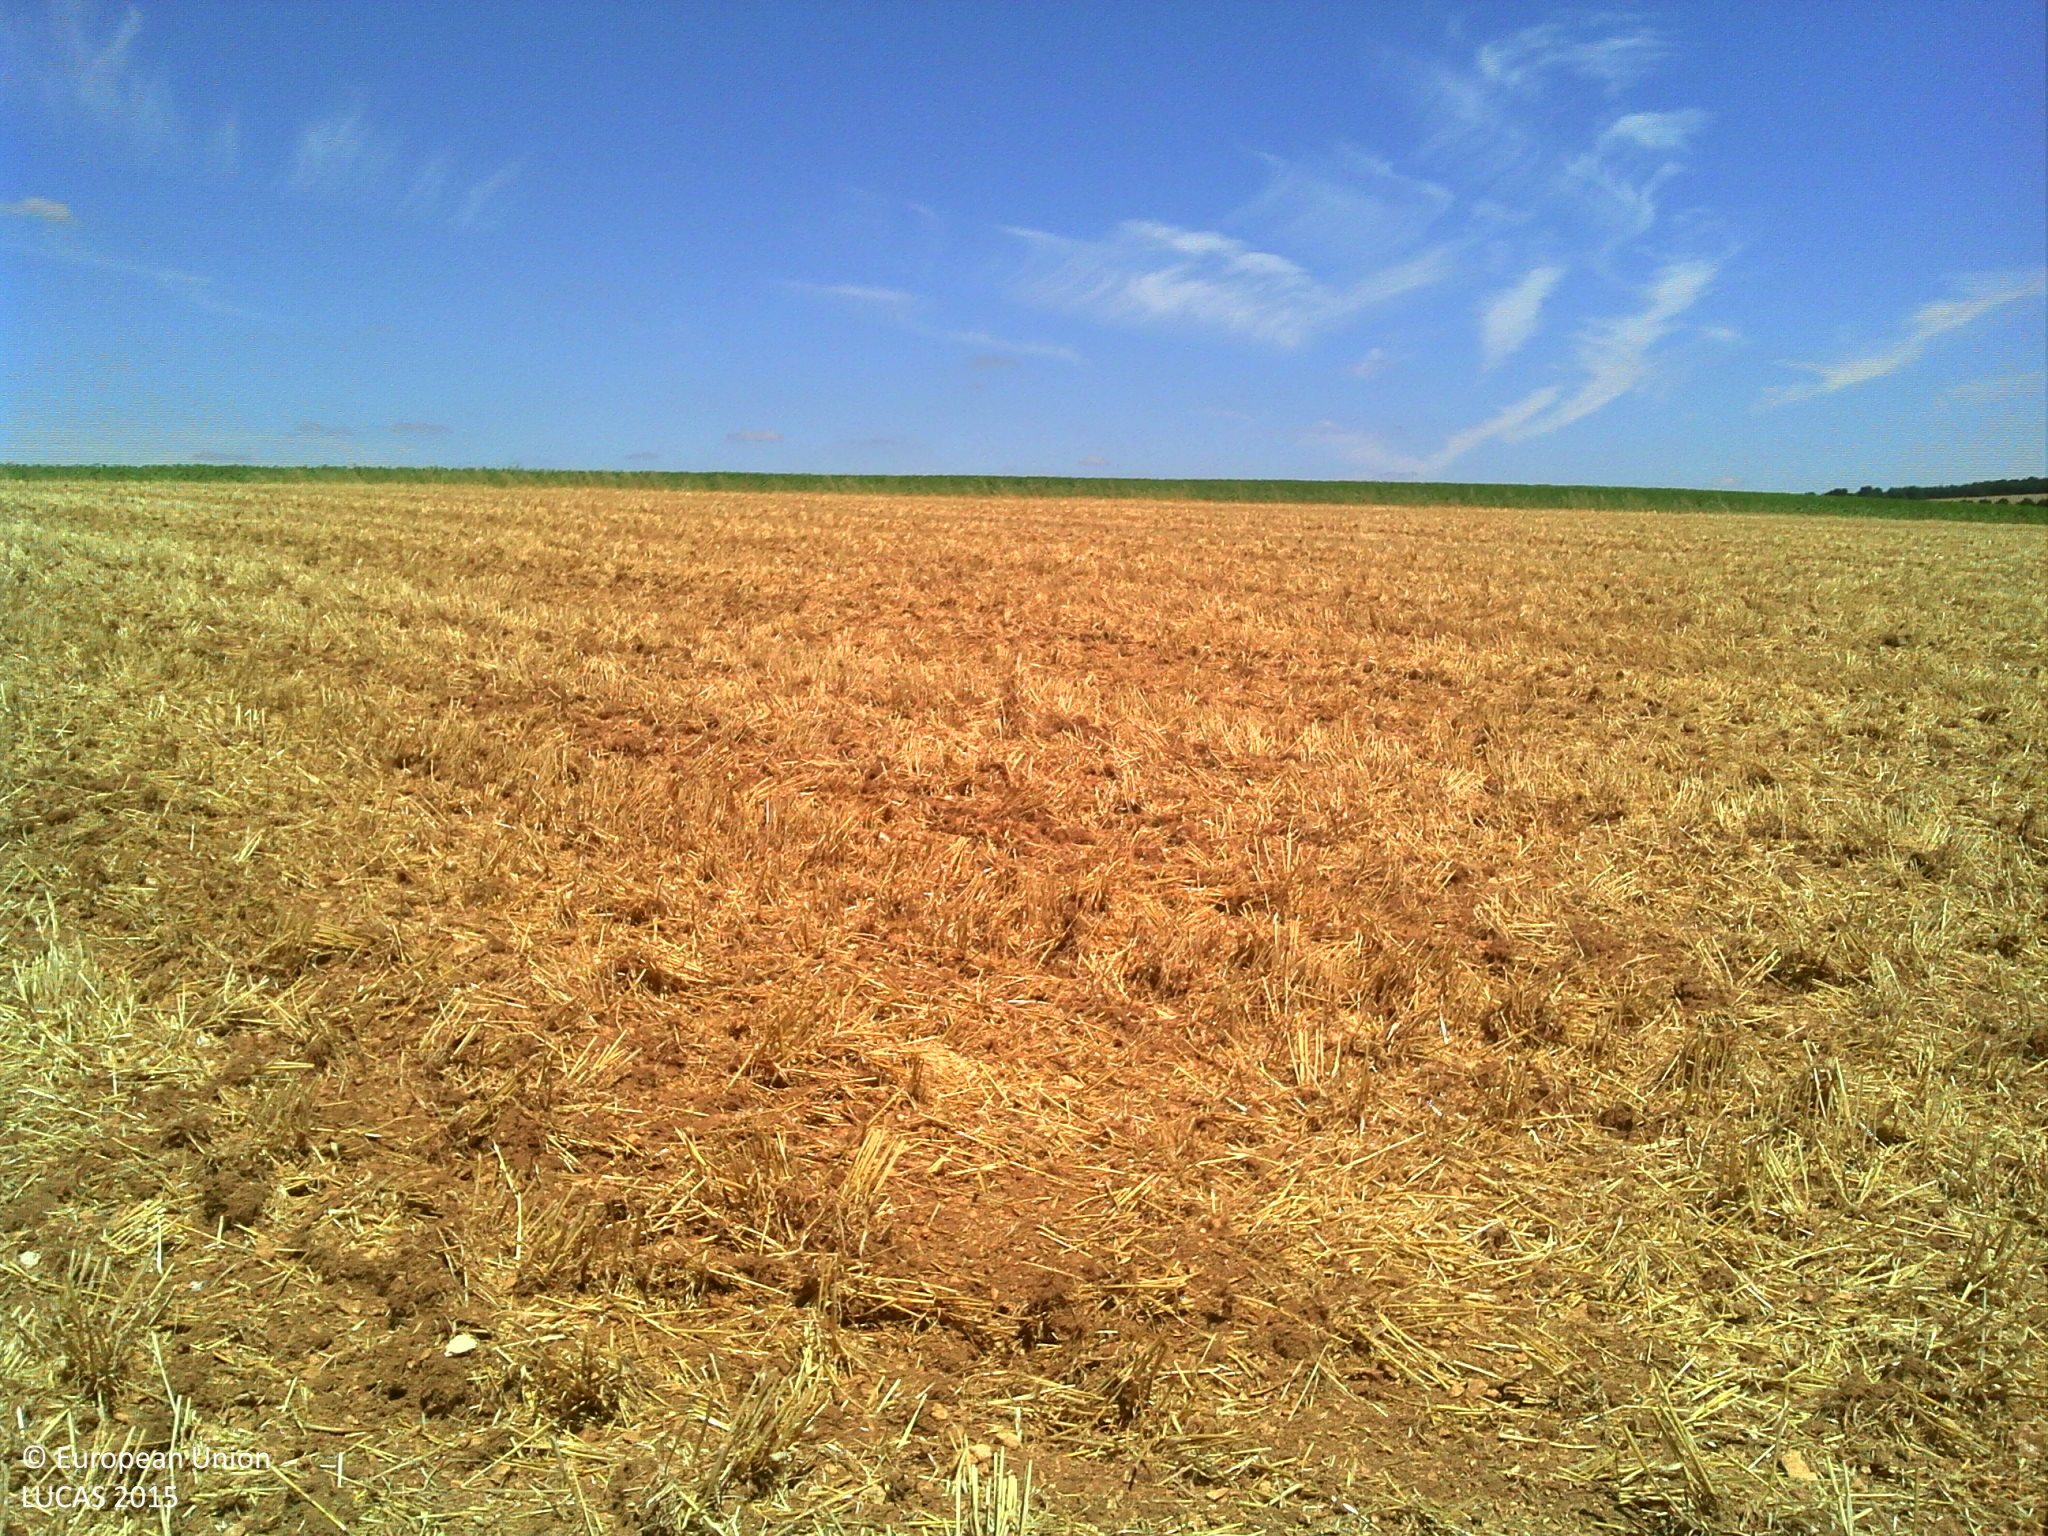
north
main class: Cropland
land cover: Barley
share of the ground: > 75 %
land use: Agriculture (excluding fallow land and kitchen gardens)
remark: Harvested field
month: June
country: FR
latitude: 47.1986
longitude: 2.6146
